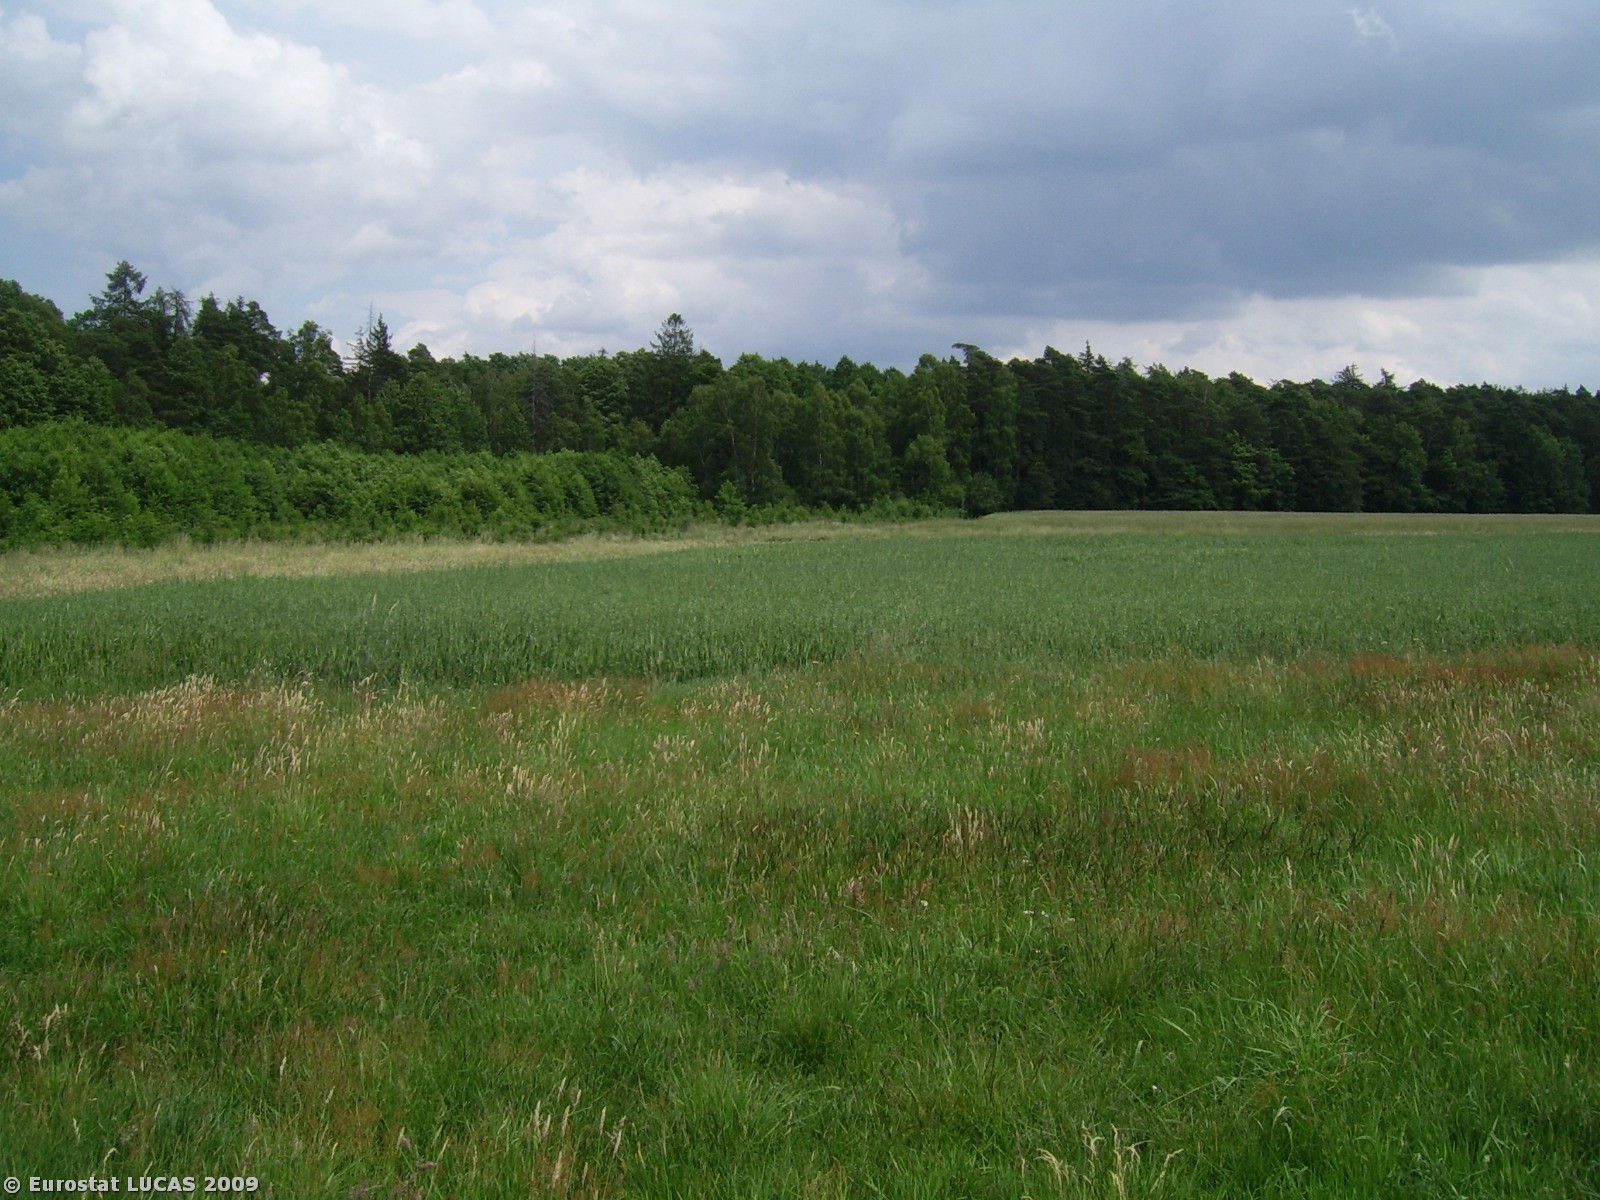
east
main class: Grassland
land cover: Grassland without tree/shrub cover
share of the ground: > 75 %
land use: Agriculture (excluding fallow land and kitchen gardens)
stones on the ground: < 10 %
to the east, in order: Grassland without tree/shrub cover; Ditches and canals; Broadleaved woodland
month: June
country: PL
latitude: 51.4943
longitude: 17.9810
